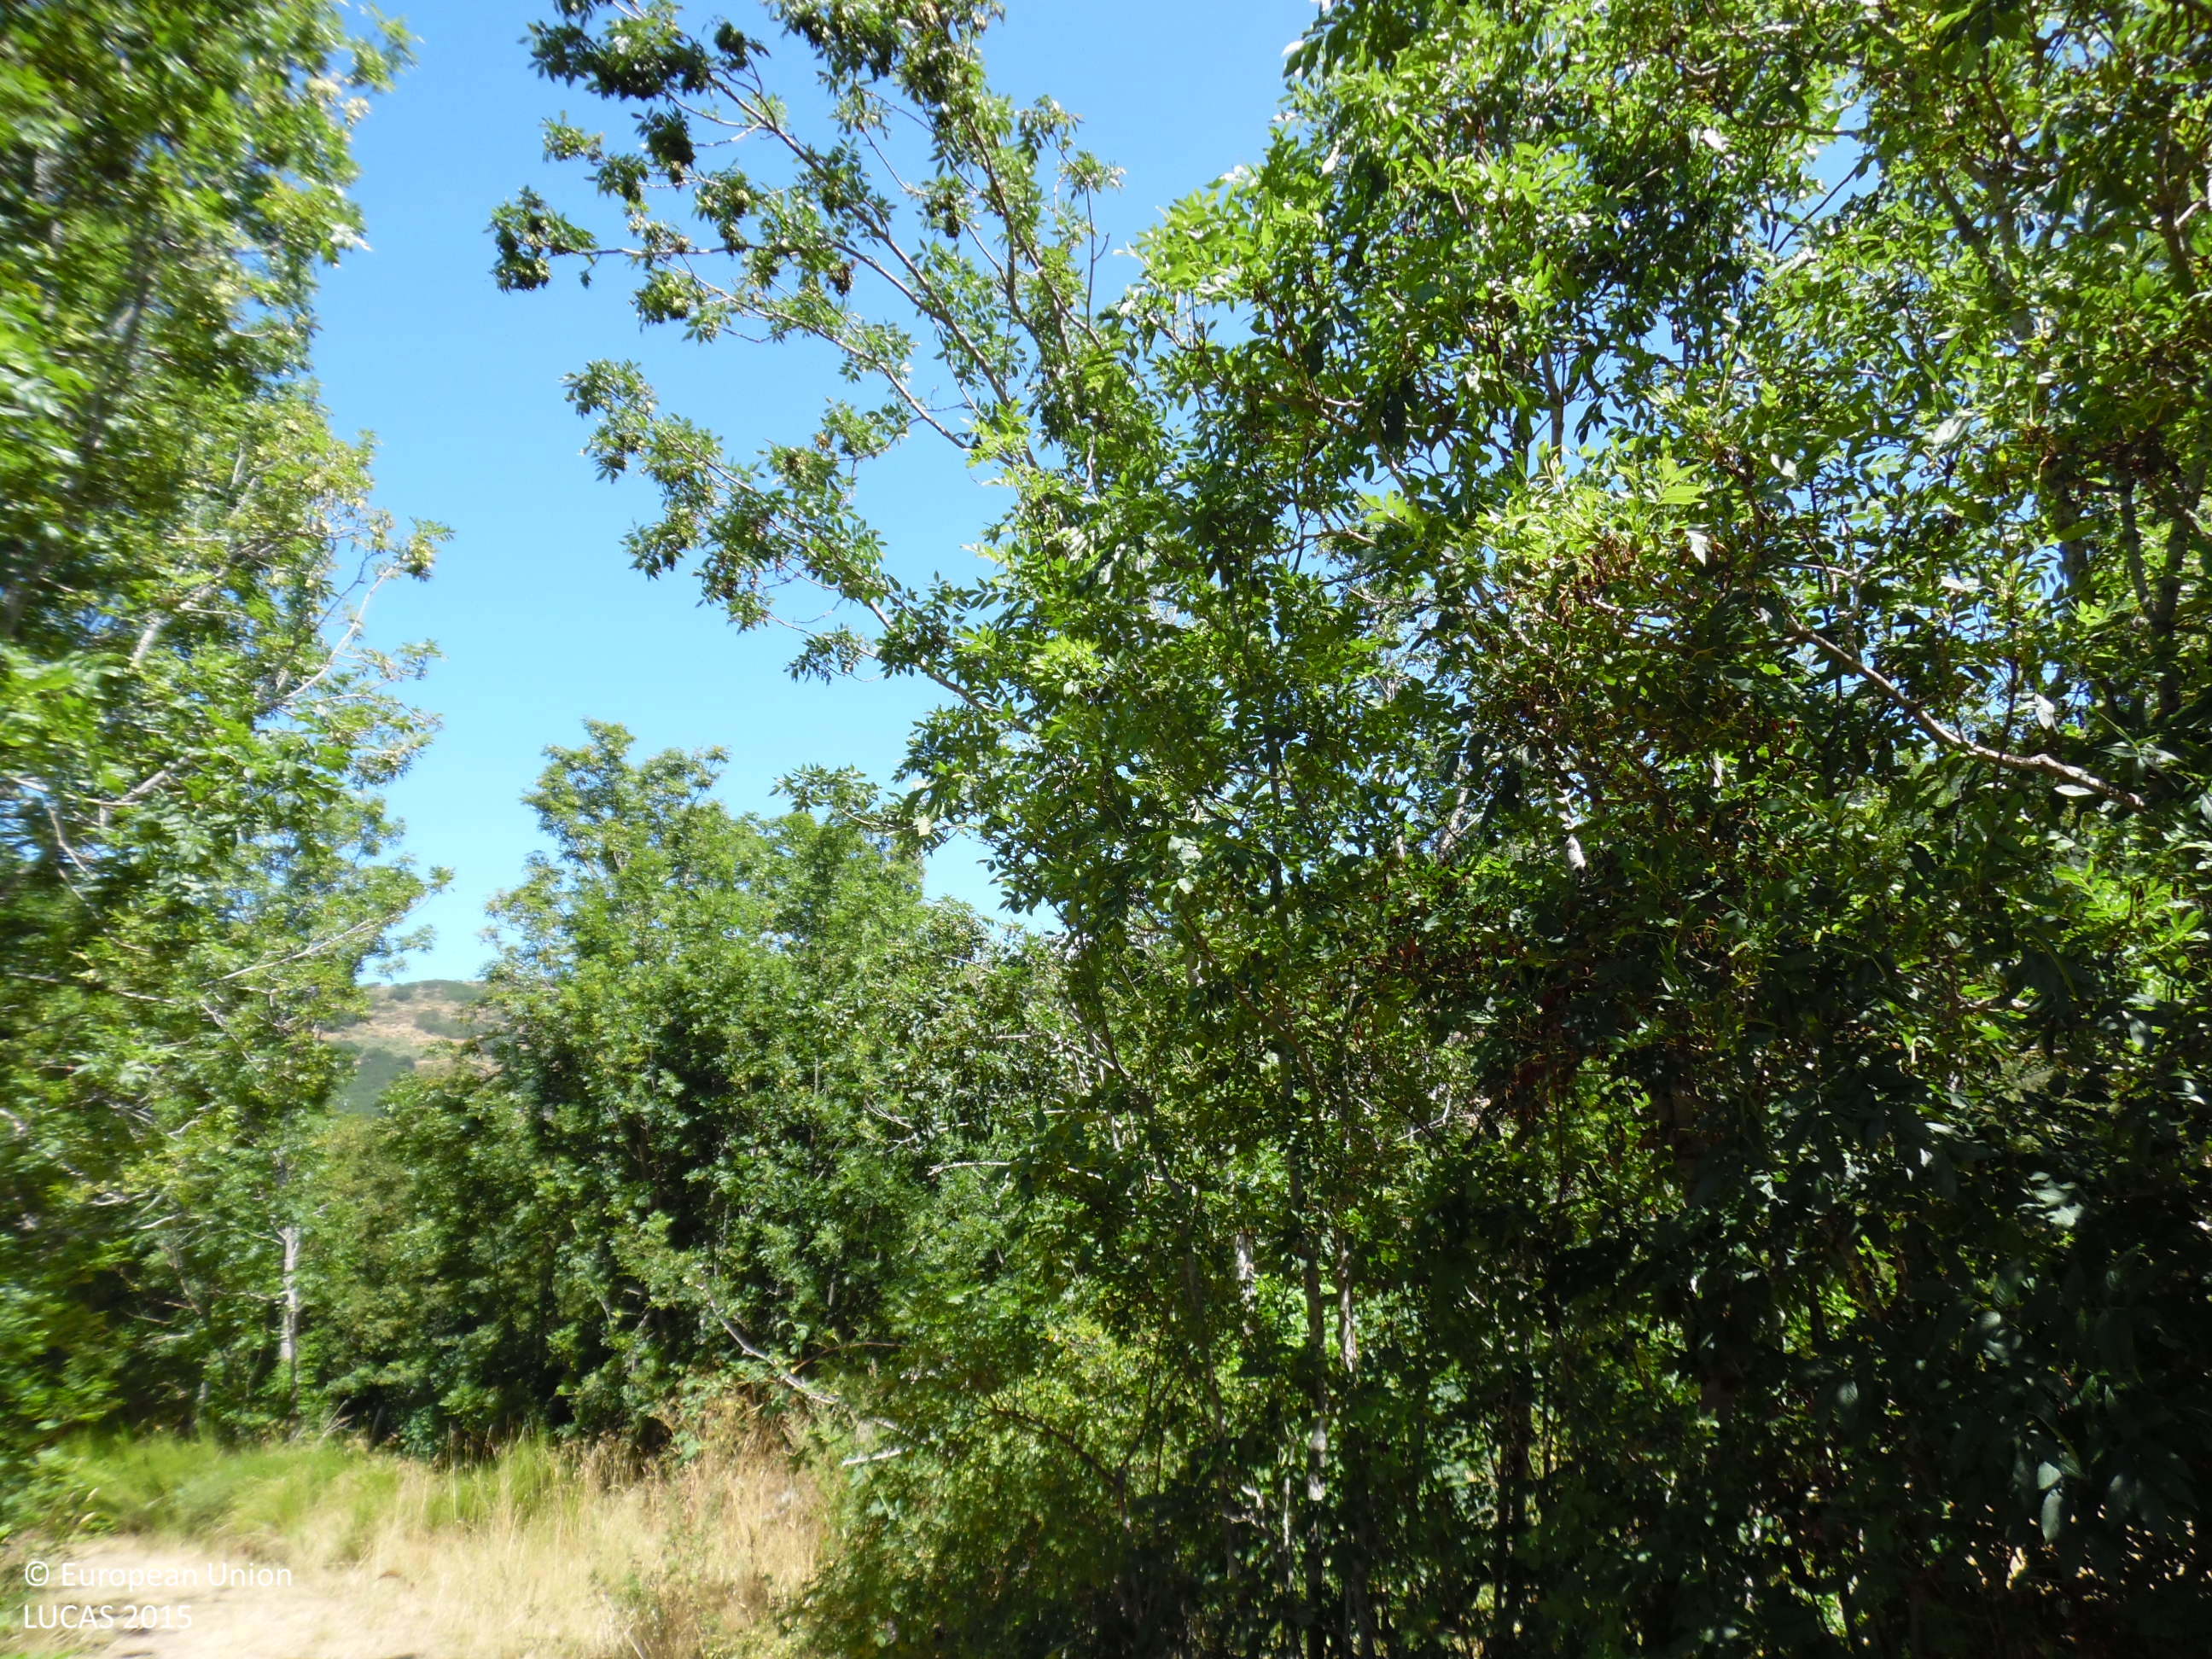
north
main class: Shrubland
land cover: Shrubland without tree cover
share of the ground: > 75 %
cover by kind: shrubs 100 %
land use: Semi-natural and natural areas not in use
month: August
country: ES
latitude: 42.7933
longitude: -6.1902
